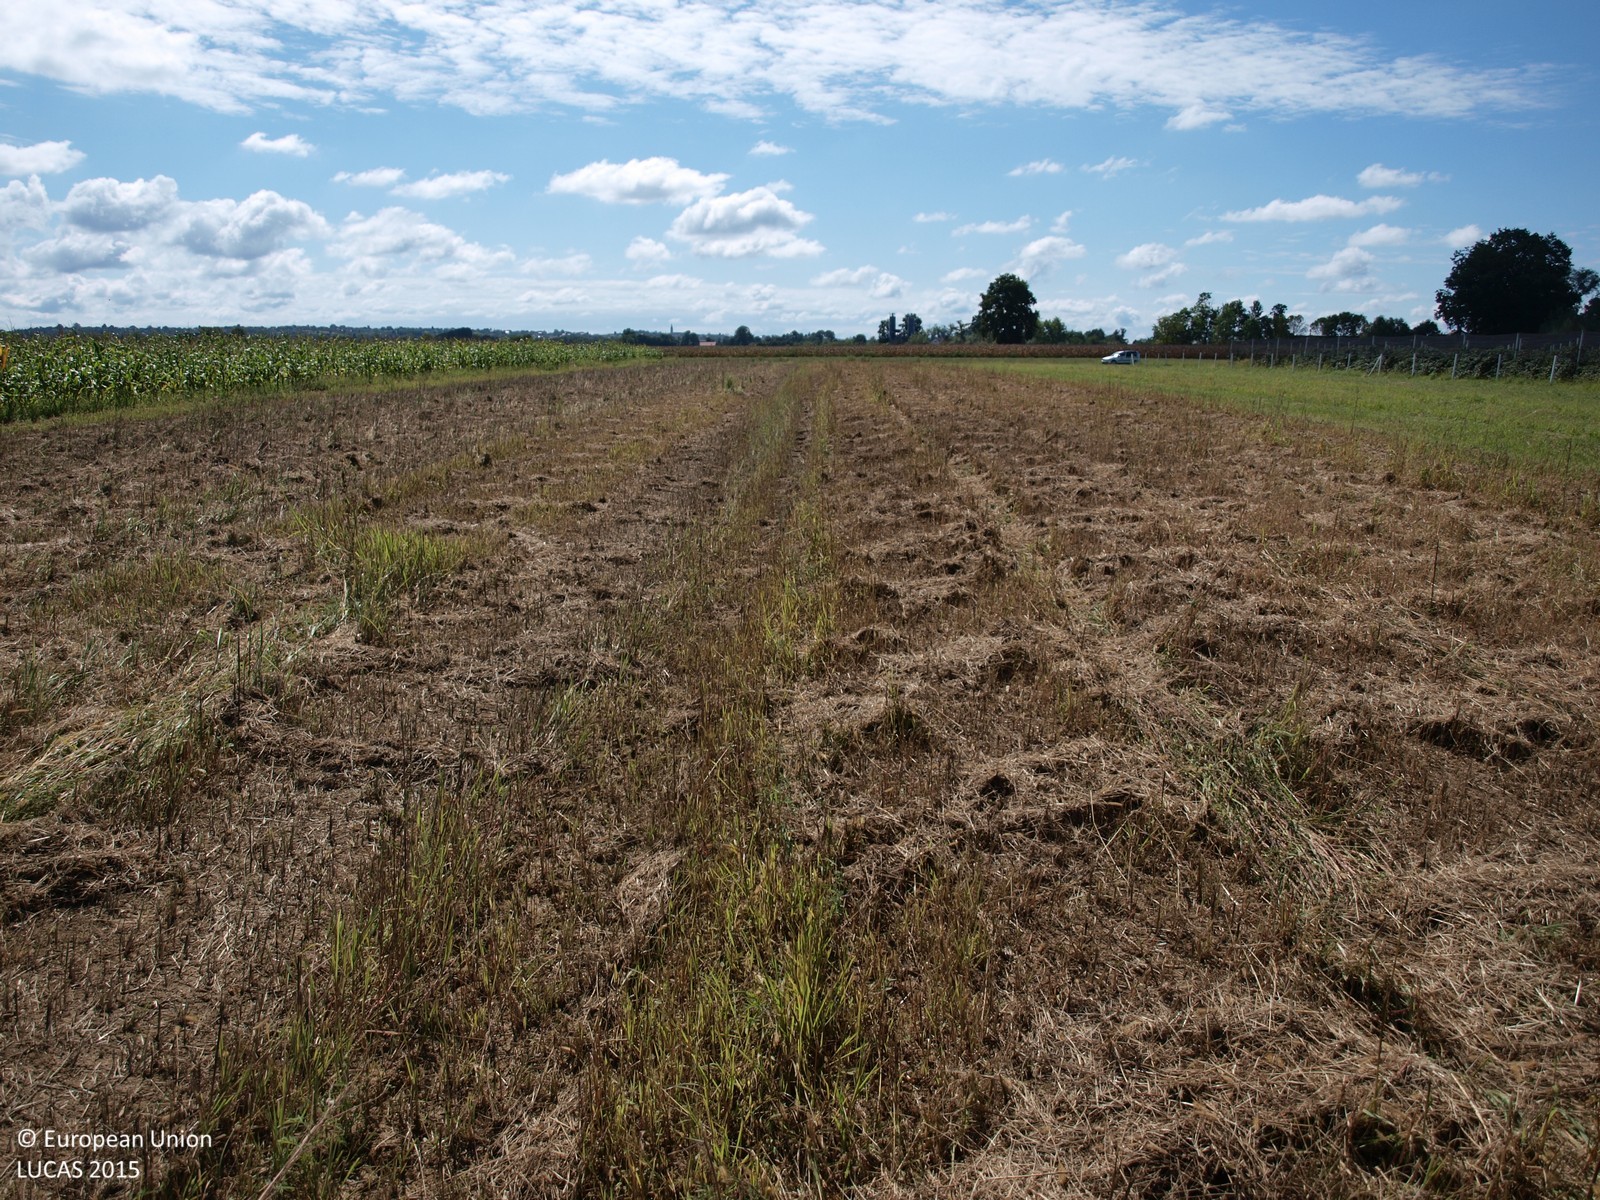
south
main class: Grassland
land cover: Grassland without tree/shrub cover
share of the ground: > 75 %
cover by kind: herbaceous plants 100 %
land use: Agriculture (excluding fallow land and kitchen gardens)
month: September
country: HR
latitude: 45.7791
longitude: 16.4166
